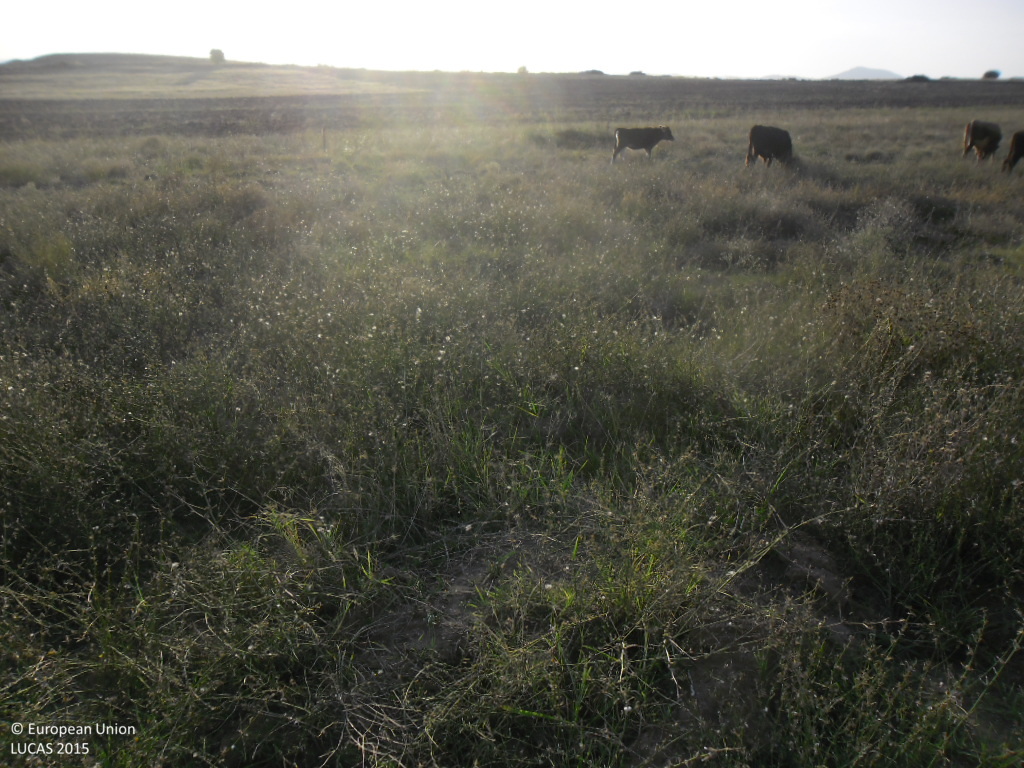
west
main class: Grassland
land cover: Grassland without tree/shrub cover
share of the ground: > 75 %
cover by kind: herbaceous plants 100 %
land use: Agriculture (excluding fallow land and kitchen gardens)
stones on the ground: < 10 %
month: September
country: BG
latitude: 41.5184
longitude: 23.2865
